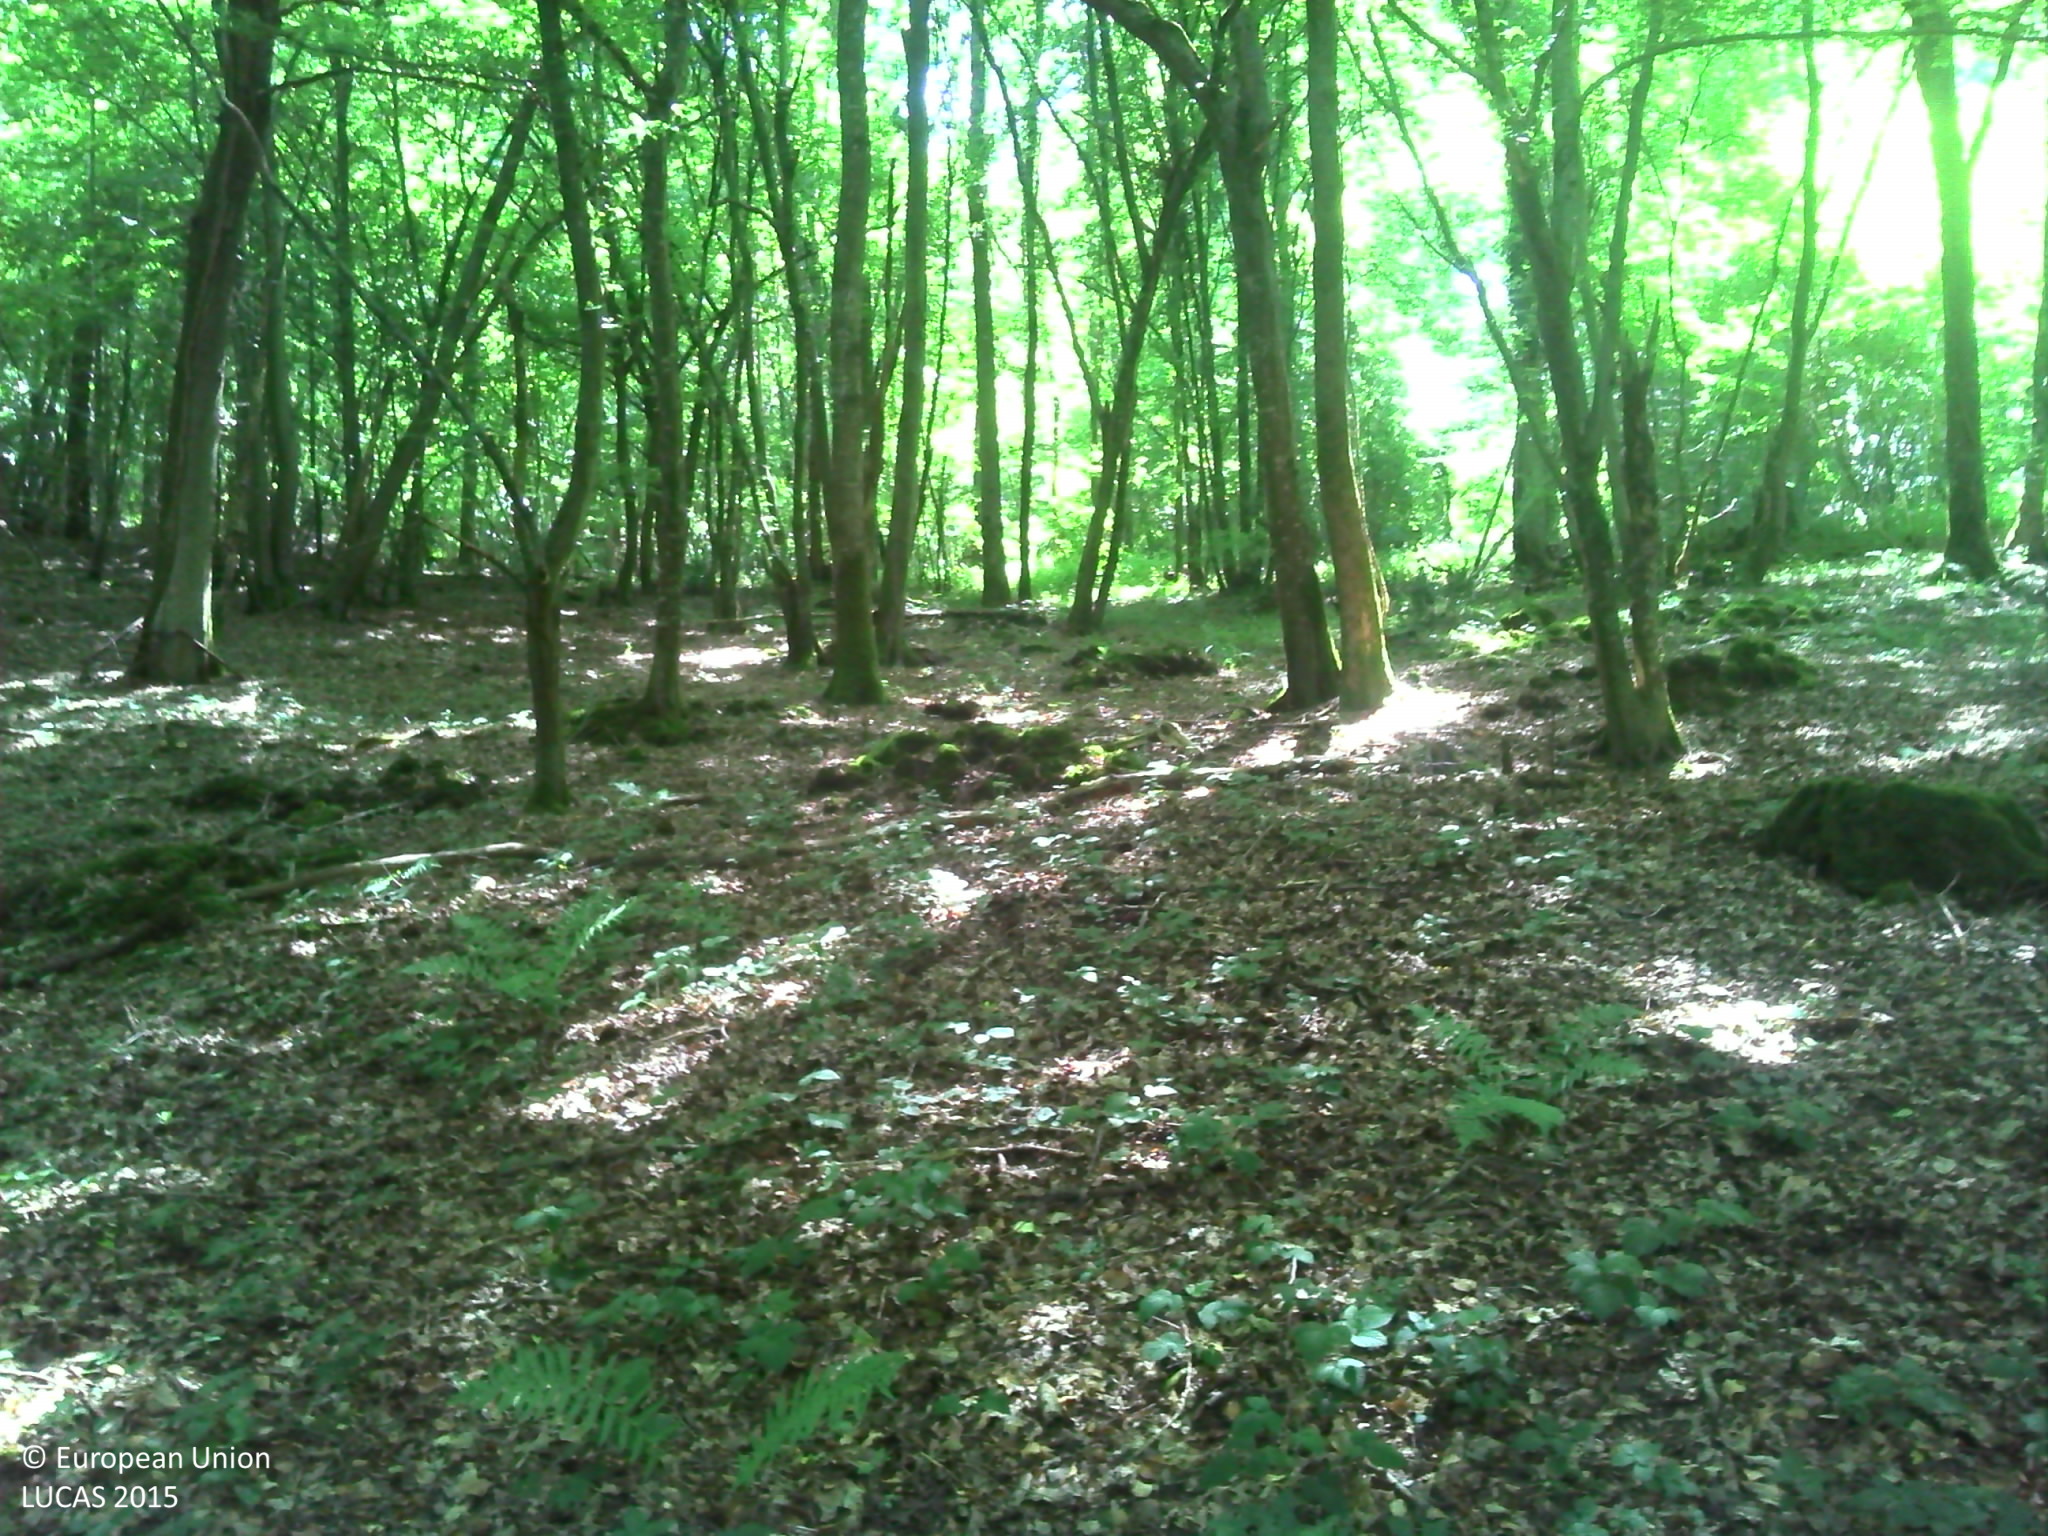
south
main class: Woodland
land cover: Broadleaved woodland
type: mesophytic deciduous forest
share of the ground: > 75 %
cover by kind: broadleaved forest trees 80 %, herbaceous plants 10 %, lichens and mosses 5 %, consolidated bare surface 5 %
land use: Forestry
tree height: > 5 m
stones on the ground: < 10 %
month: June
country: FR
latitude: 49.0930
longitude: 1.0913
